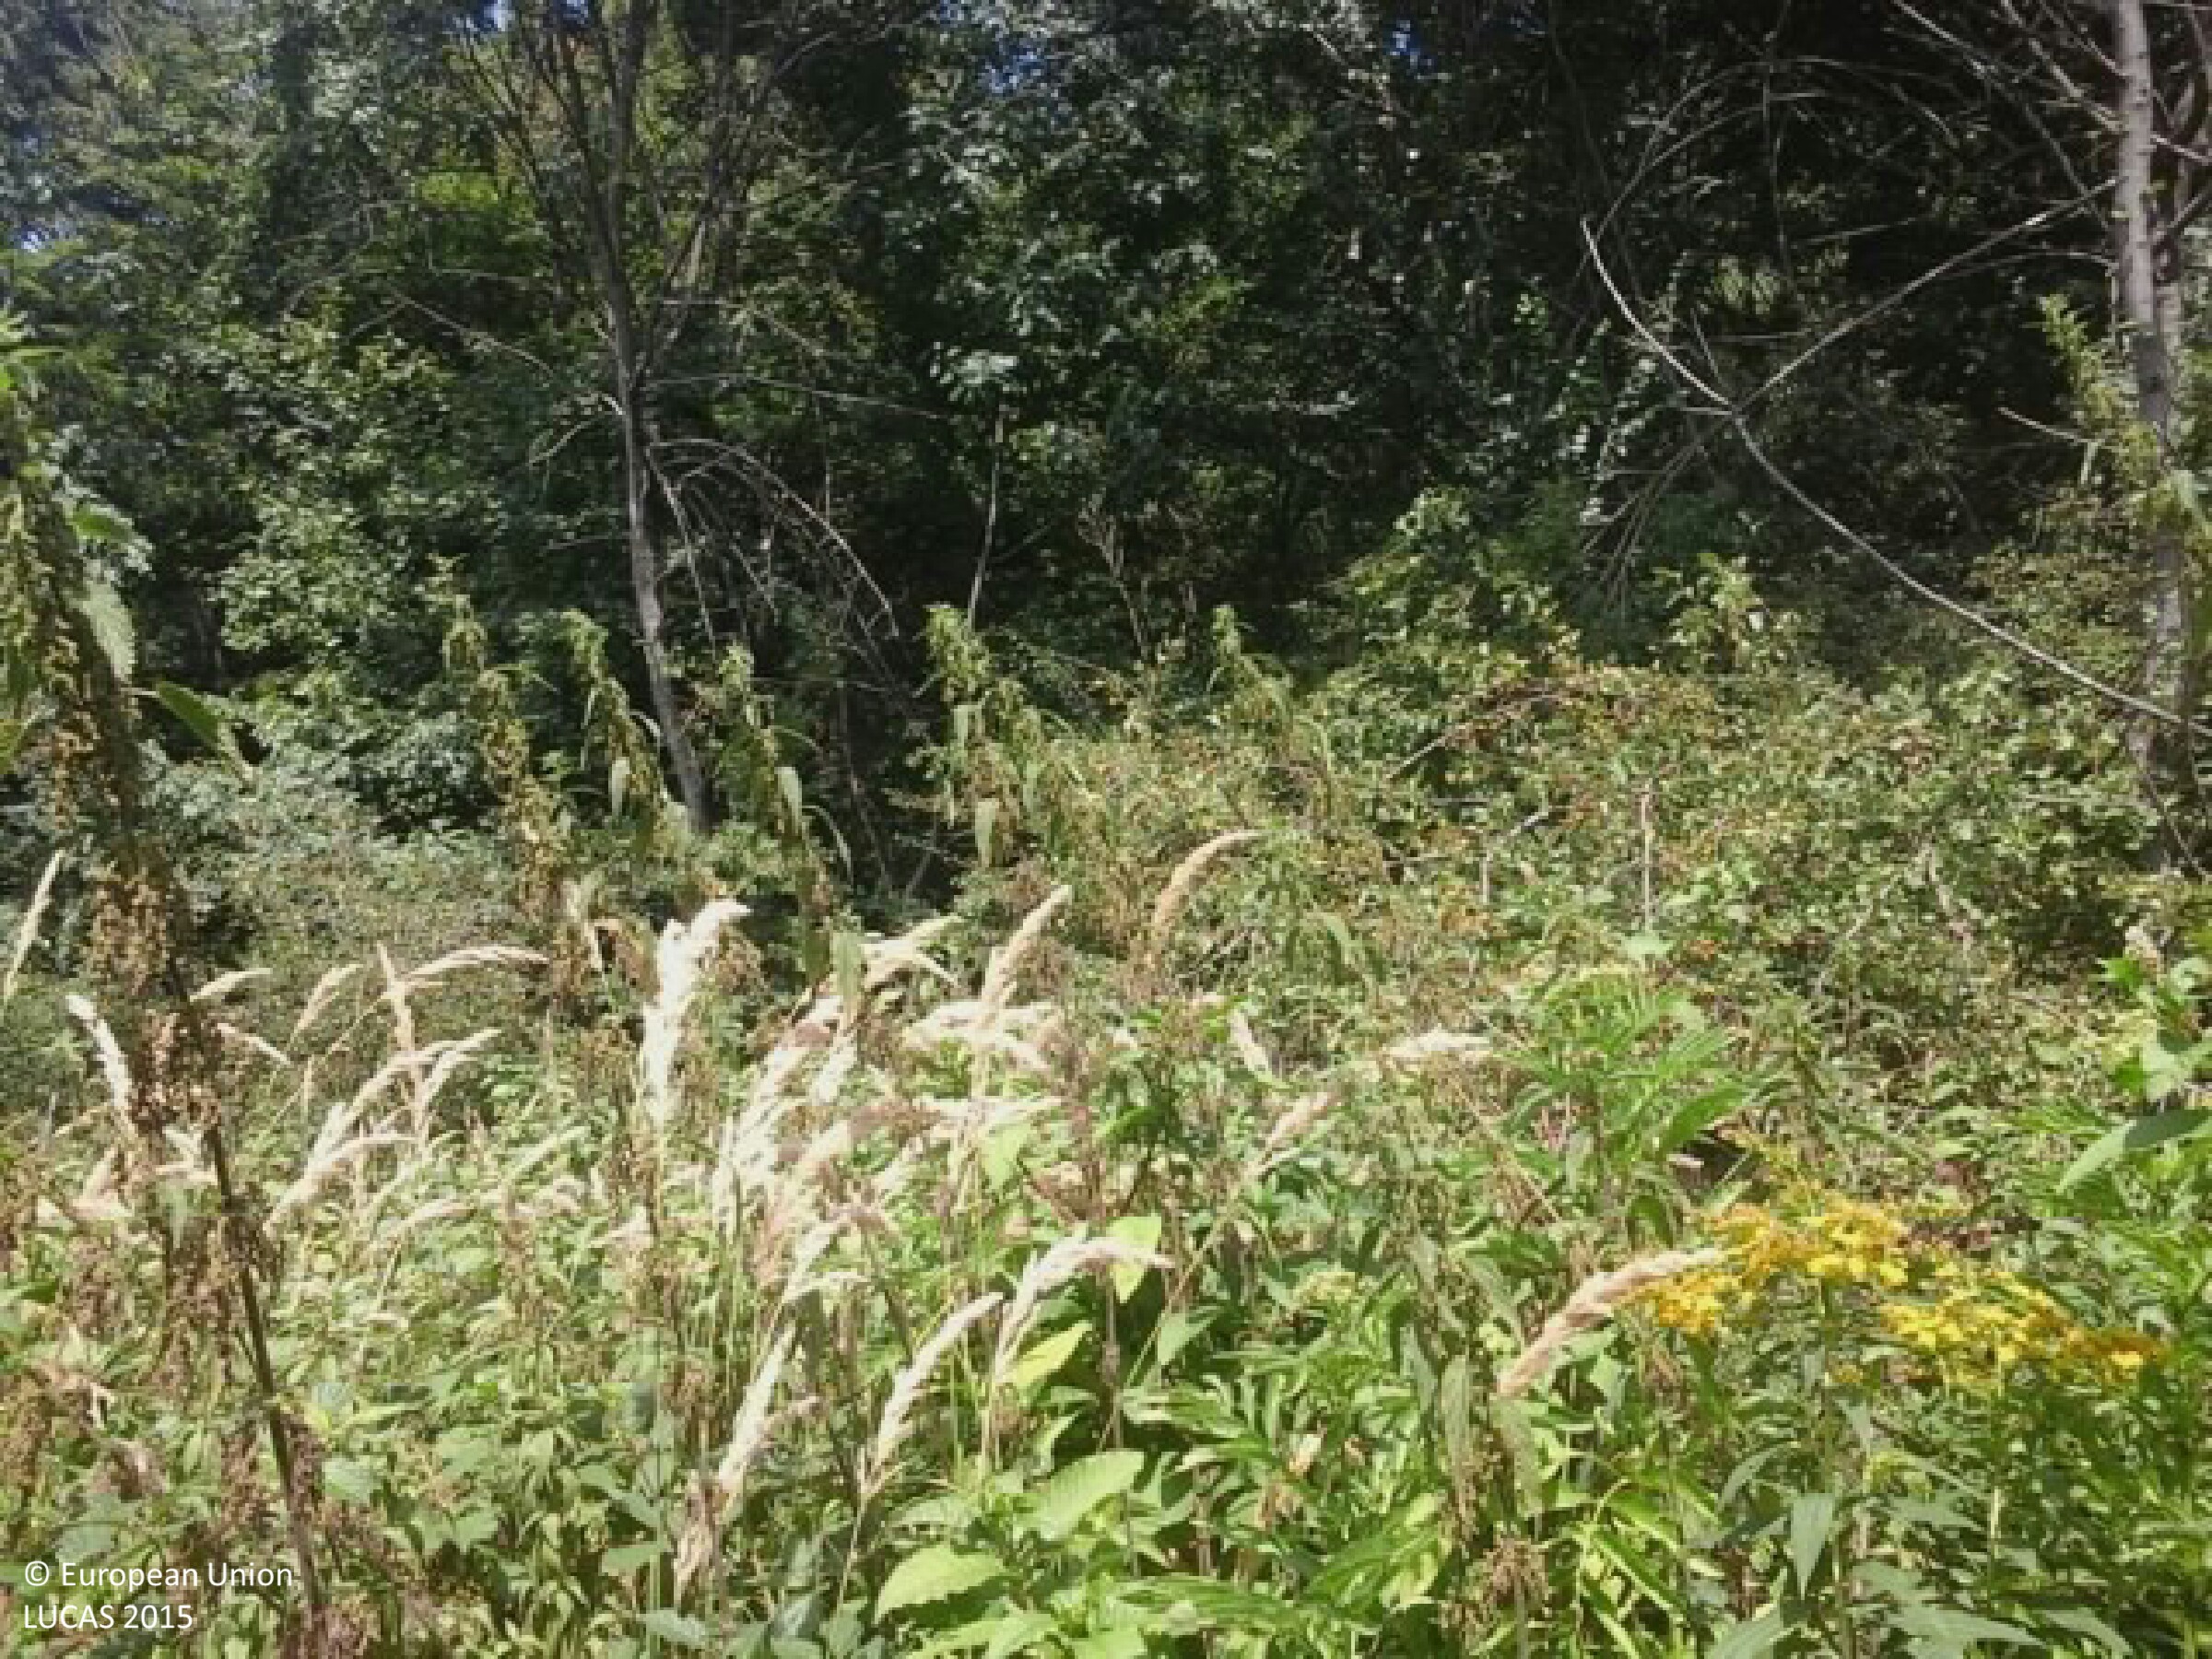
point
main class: Woodland
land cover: Broadleaved woodland
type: mesophytic deciduous forest
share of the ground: > 75 %
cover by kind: broadleaved forest trees 95 %, herbaceous plants 5 %
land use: Forestry
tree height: > 5 m
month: August
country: HU
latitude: 46.1742
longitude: 18.2849
